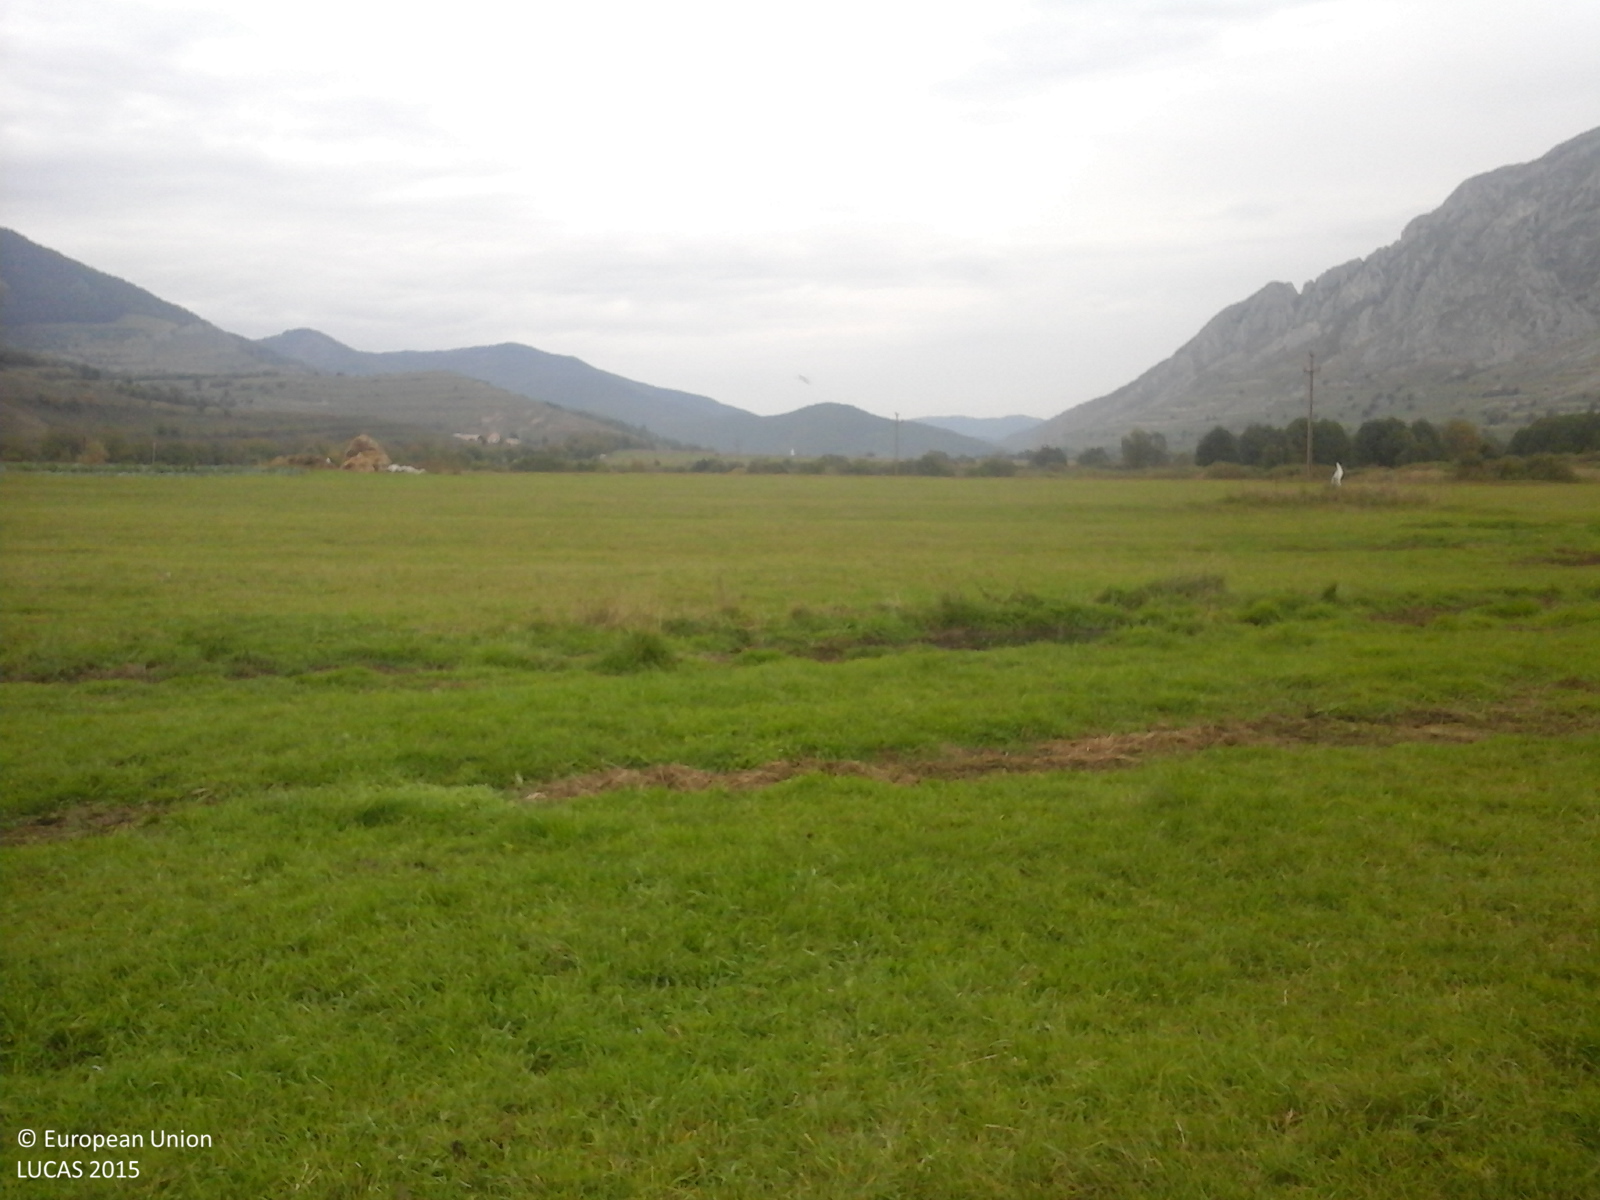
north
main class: Grassland
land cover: Grassland without tree/shrub cover
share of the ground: > 75 %
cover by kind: herbaceous plants 100 %
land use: Agriculture (excluding fallow land and kitchen gardens)
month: October
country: RO
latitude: 46.4315
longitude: 23.5639
